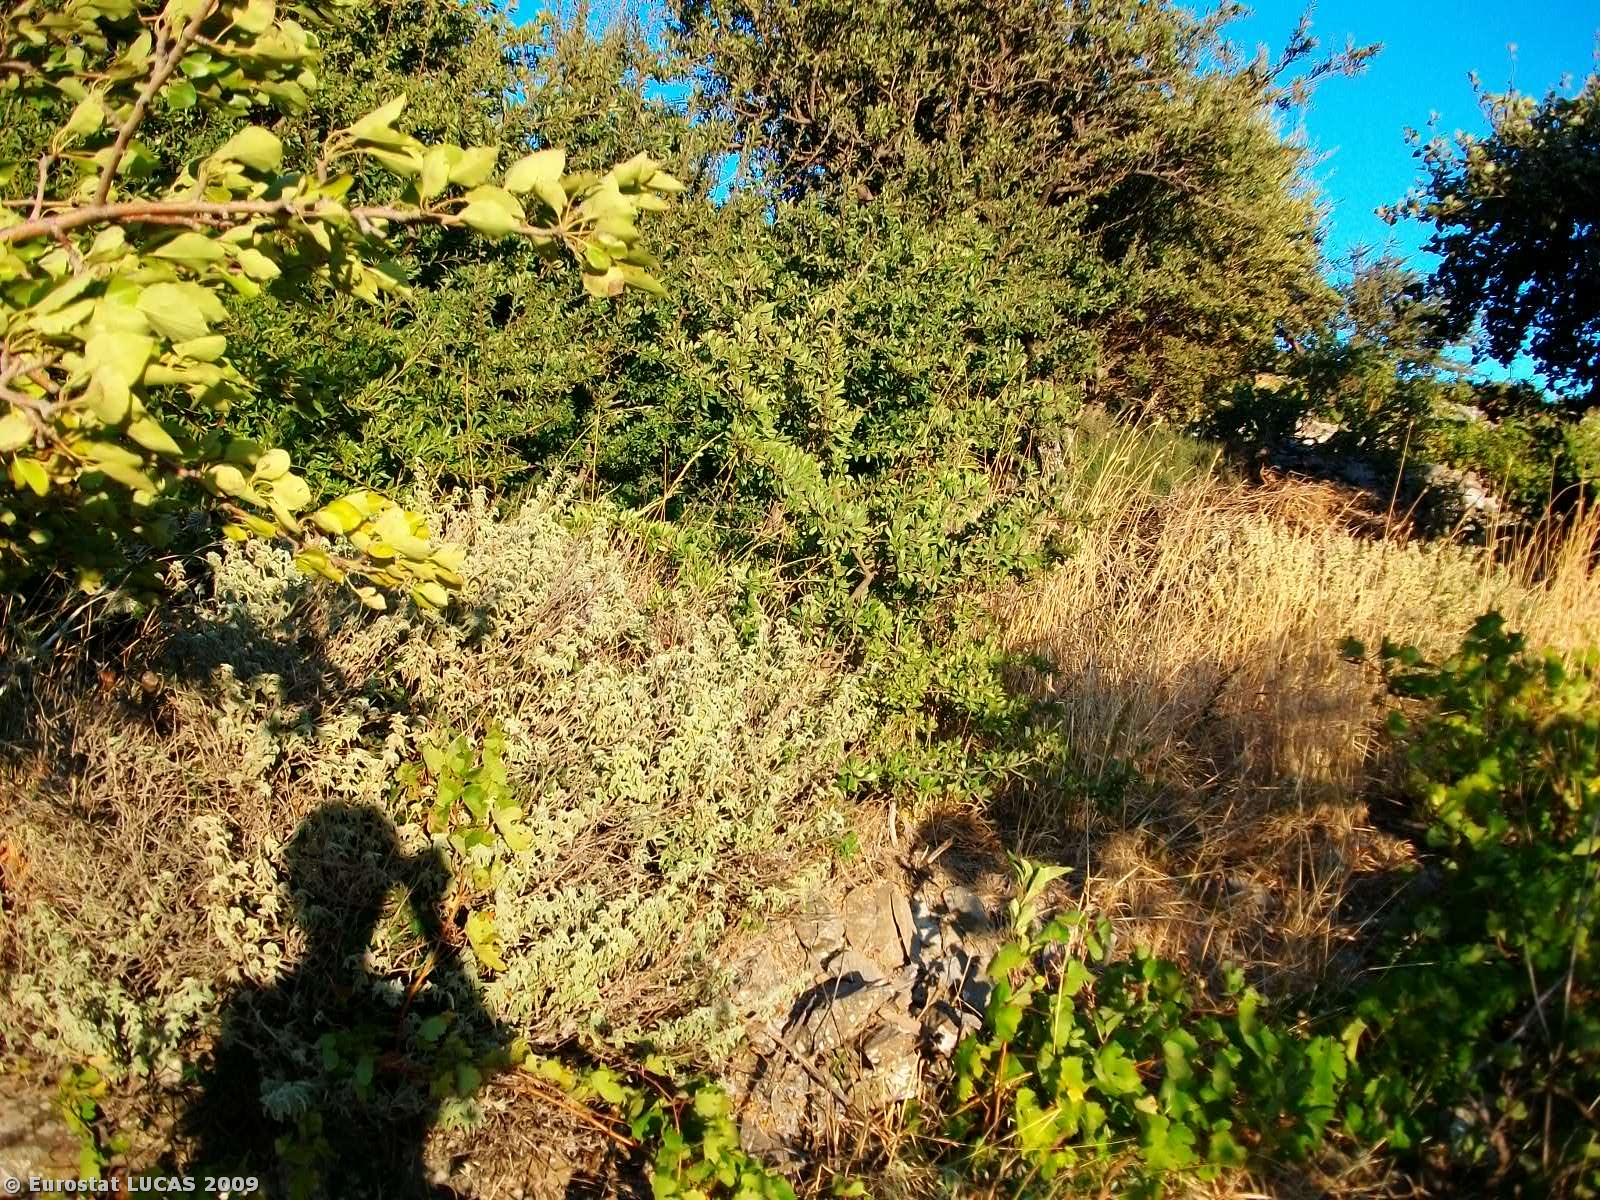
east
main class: Shrubland
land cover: Shrubland with sparse tree cover
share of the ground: > 75 %
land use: Nature reserves
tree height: < 5 m
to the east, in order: Shrubland with sparse tree cover; Tracks; Bare land; Shrubland with sparse tree cover; Bare land; Shrubland with sparse tree cover
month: August
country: GR
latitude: 35.0879
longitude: 25.9127
